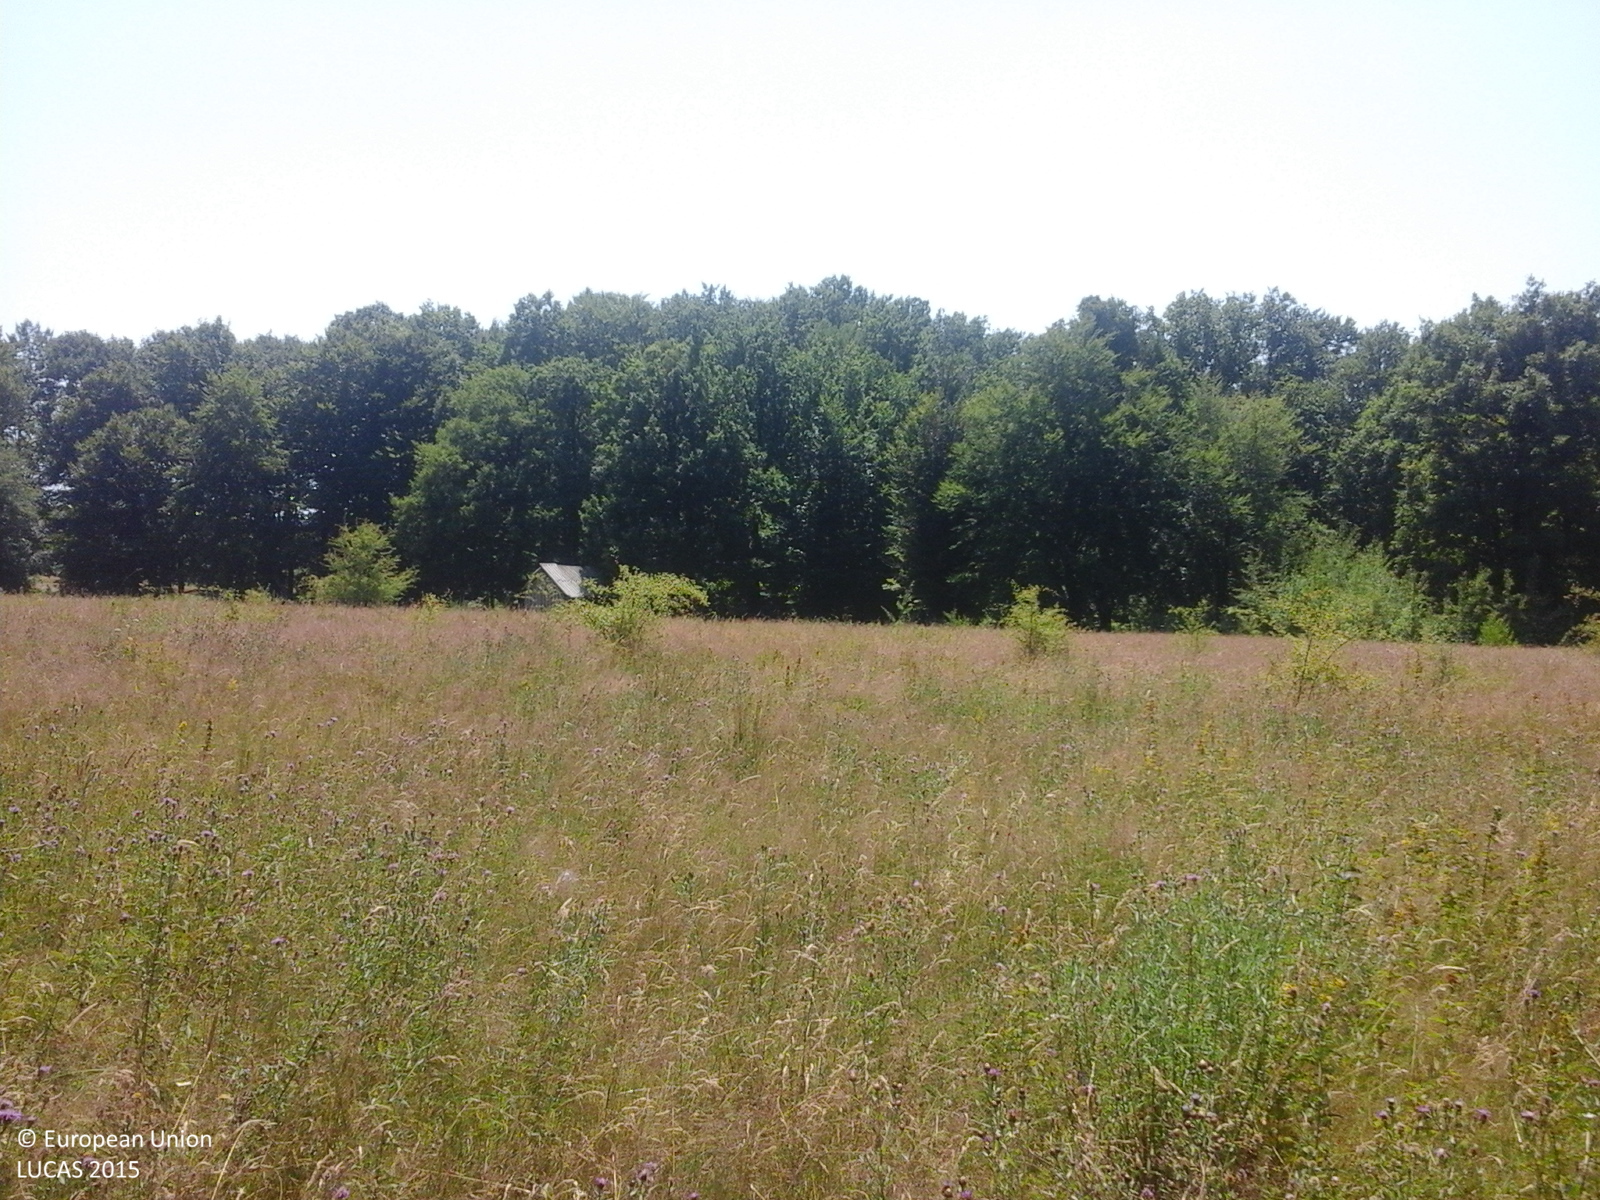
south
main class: Grassland
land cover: Grassland without tree/shrub cover
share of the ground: > 75 %
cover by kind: herbaceous plants 100 %
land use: Agriculture (excluding fallow land and kitchen gardens)
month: July
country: RO
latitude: 45.0505
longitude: 25.1089
